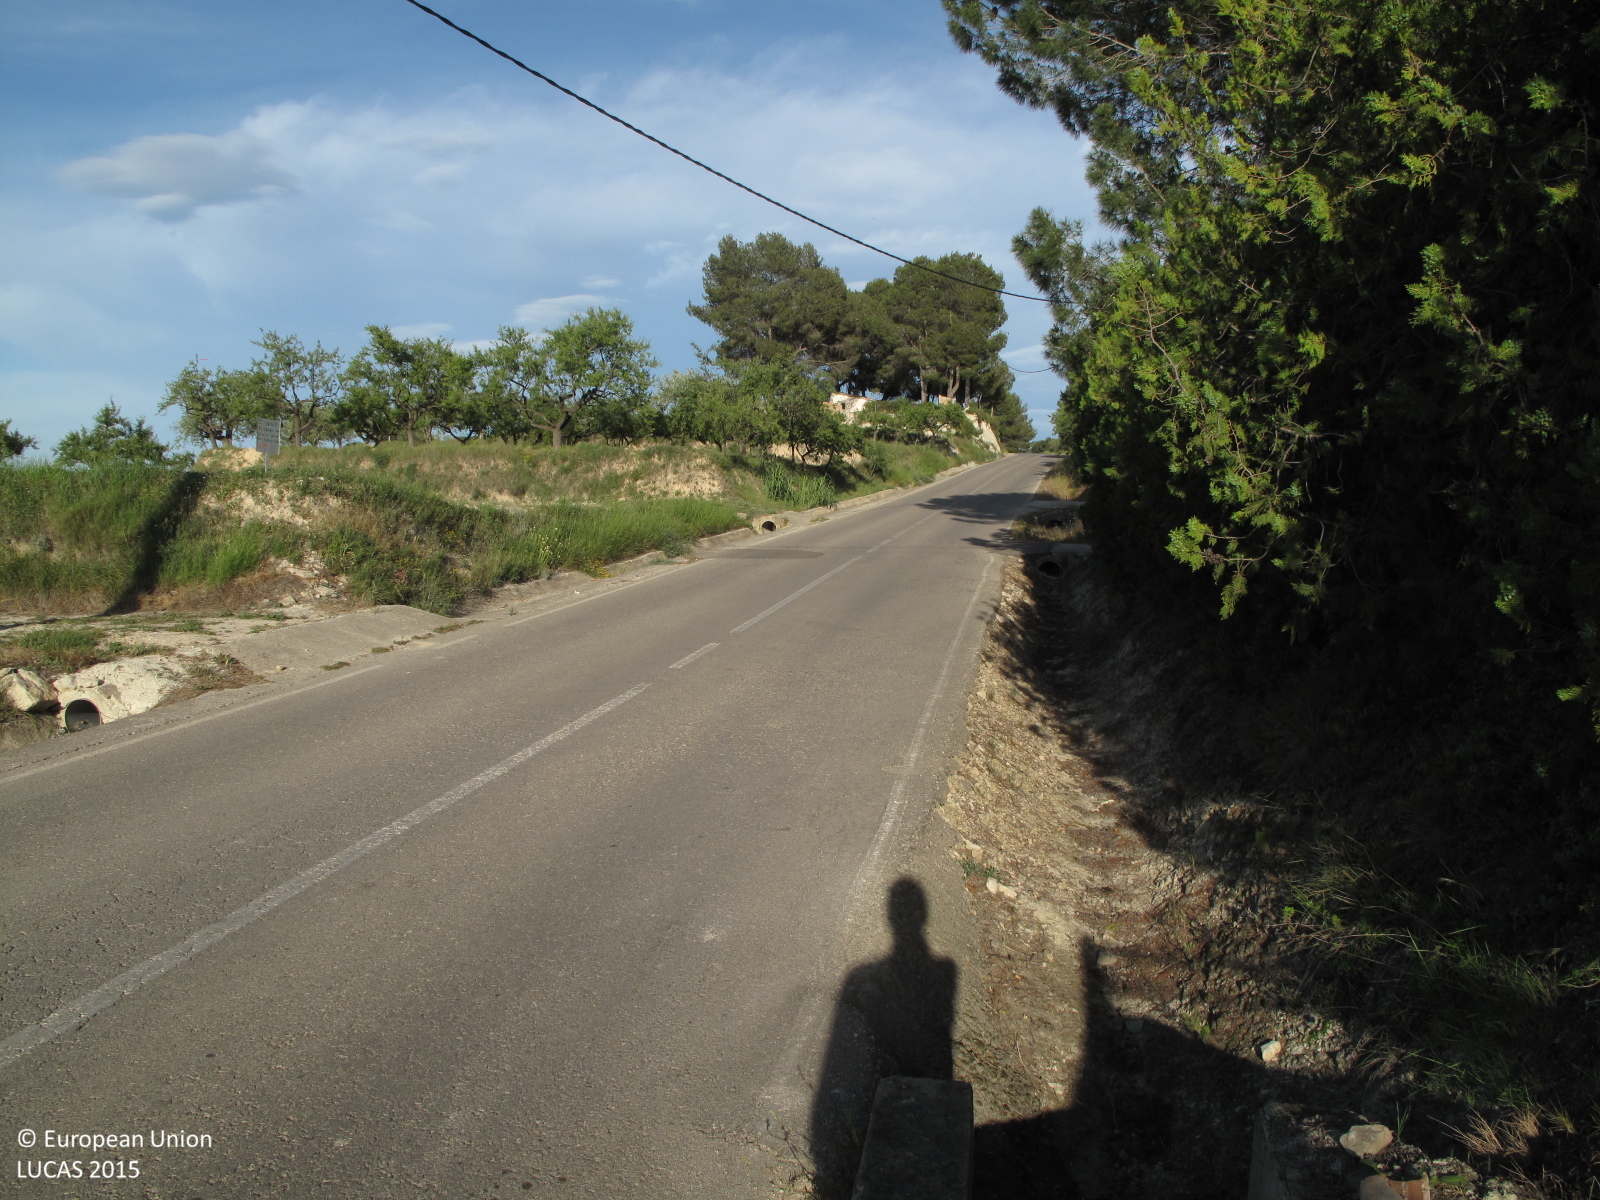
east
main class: Cropland
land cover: Olive groves
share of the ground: 50 - 75 %
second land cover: Other bare soil
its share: > 75 %
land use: Agriculture (excluding fallow land and kitchen gardens)
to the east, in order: Olive groves; Other bare soil; Managed hedges; Single bushes/trees; Managed hedges; Electric lines; Paved roads, cycling and walking lanes; Grass margins; Nuts trees; Grass margins; Nuts trees; Grass margins; Pine dominated coniferous woodland; Nuts trees; Grass margins; Spontaneously vegetated surfaces
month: May
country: ES
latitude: 38.8184
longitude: -0.5755
